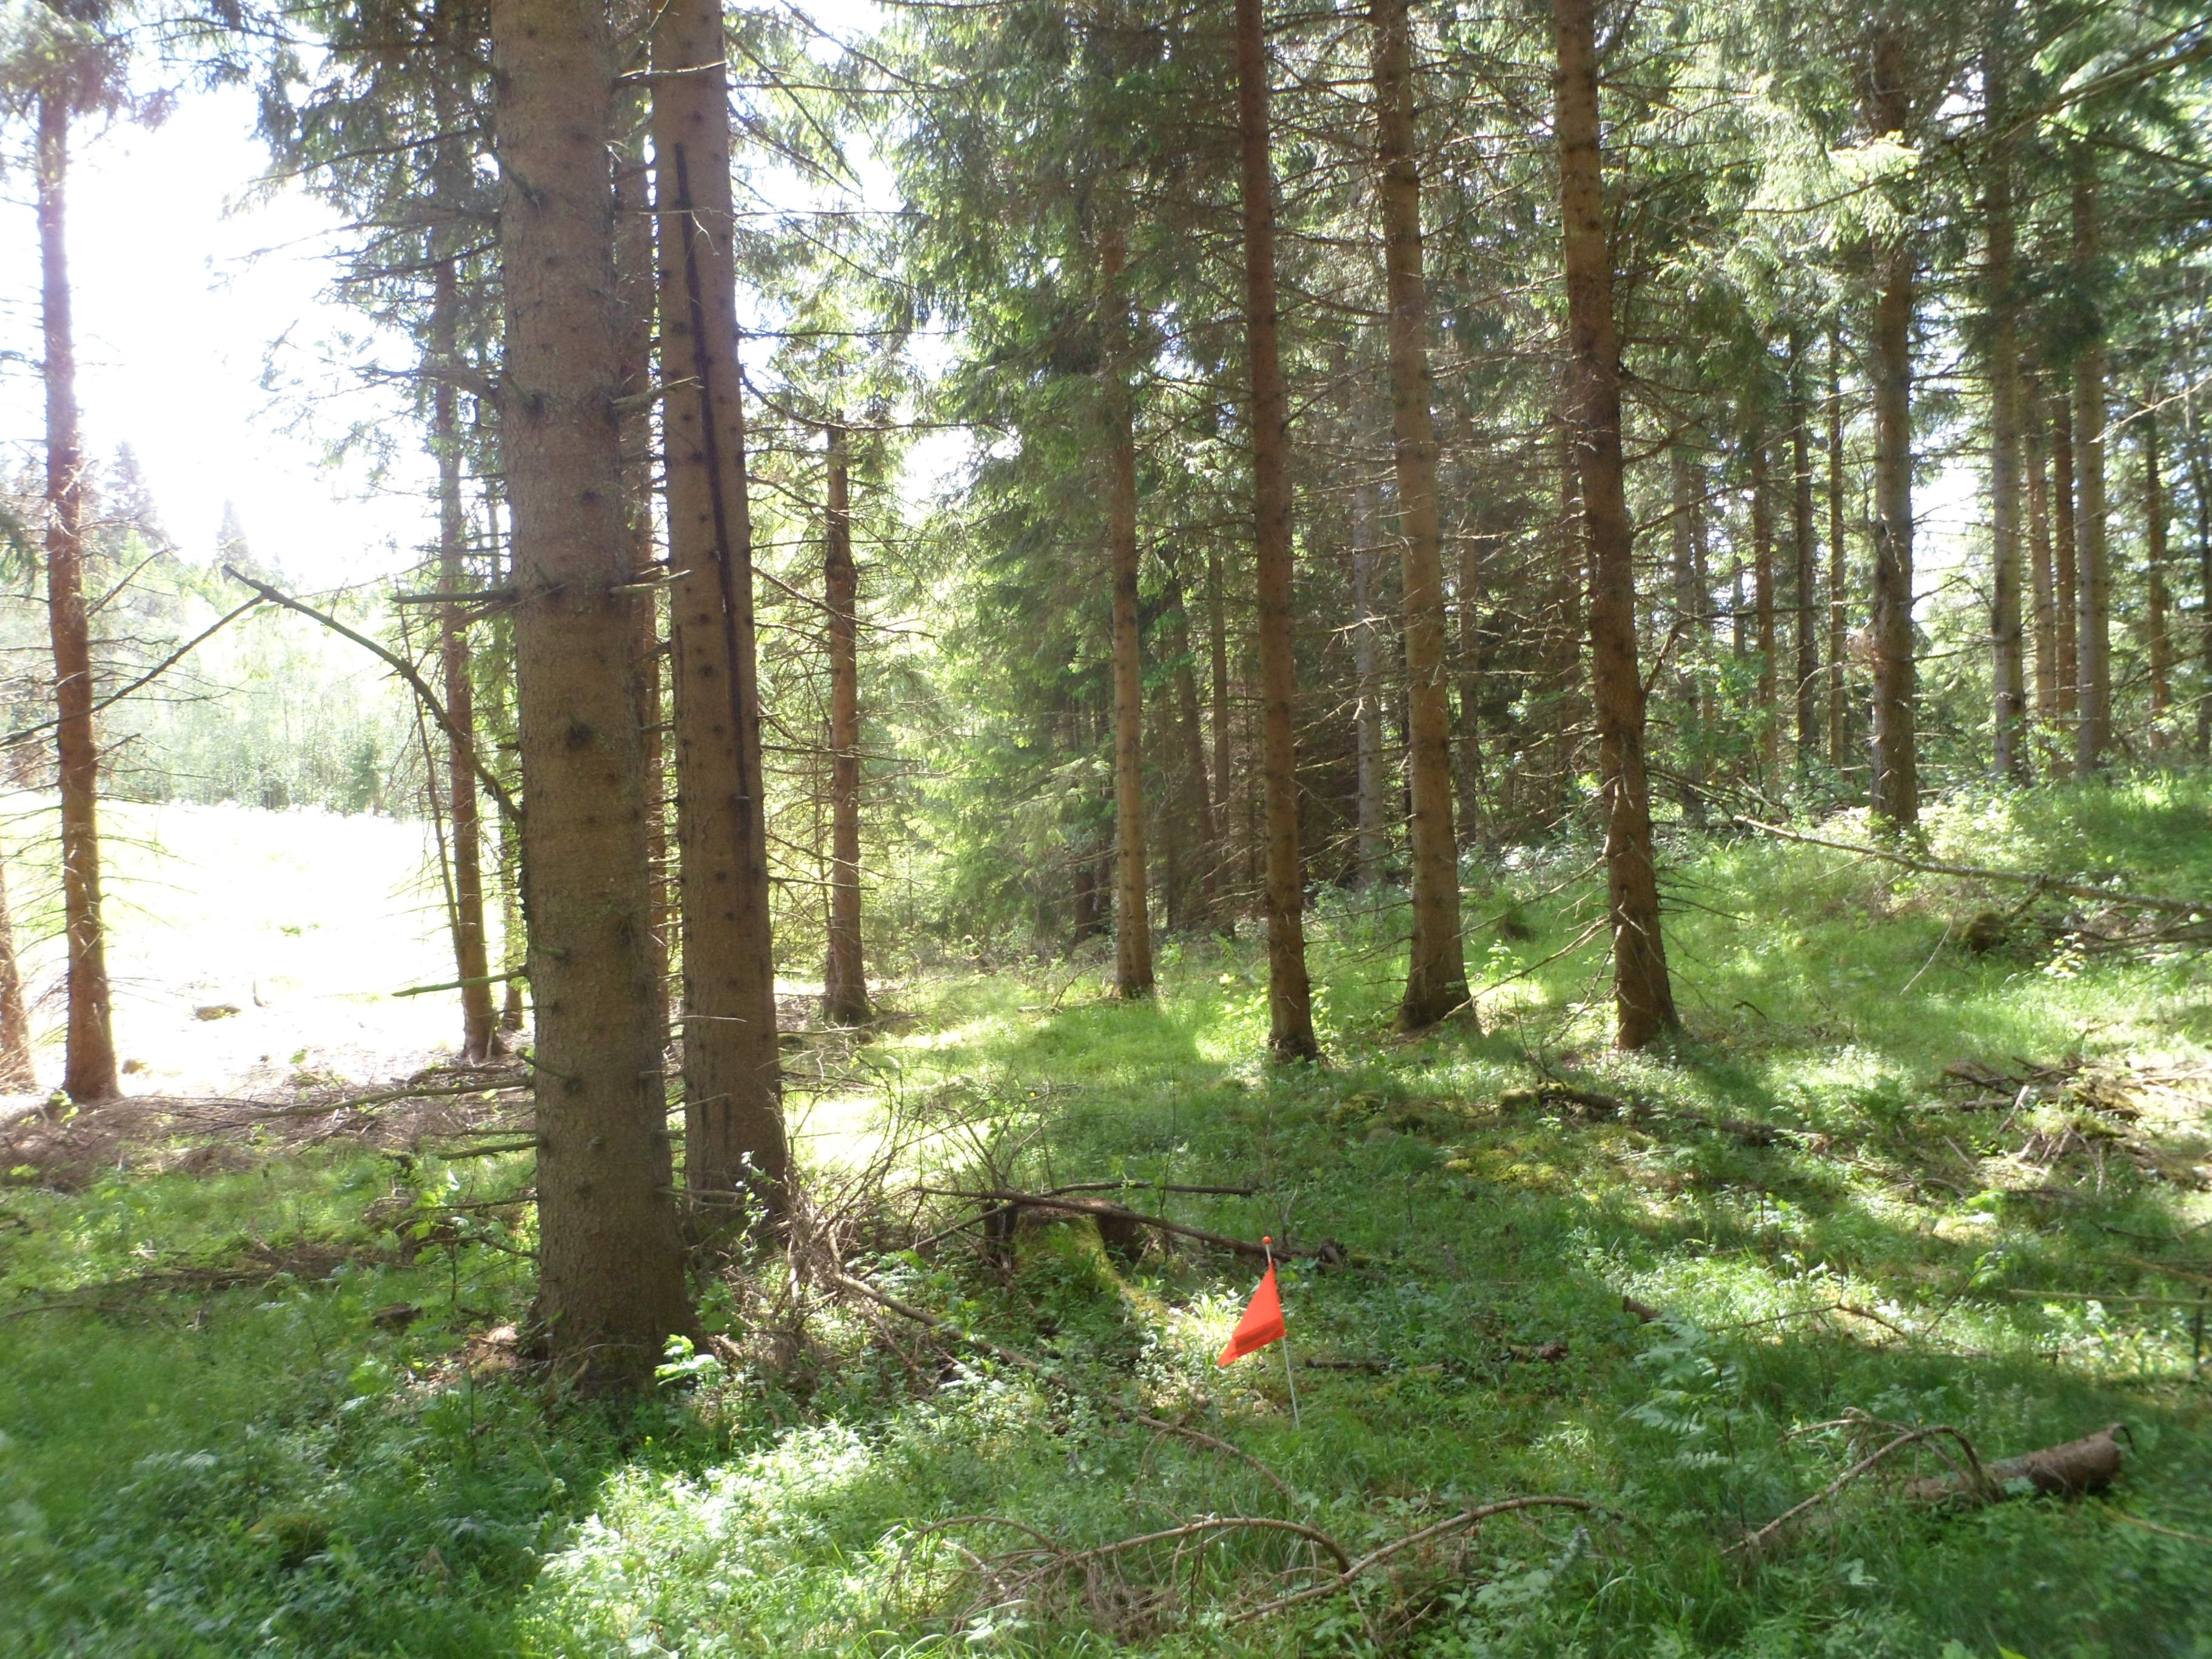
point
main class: Woodland
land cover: Spruce dominated coniferous woodland
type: boreal forest
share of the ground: 50 - 75 %
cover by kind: coniferous forest trees 60 %, herbaceous plants 20 %, shrubs 10 %, broadleaved forest trees 5 %, lichens and mosses 5 %
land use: Forestry
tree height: > 5 m
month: June
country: SE
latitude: 57.5060
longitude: 14.1847
